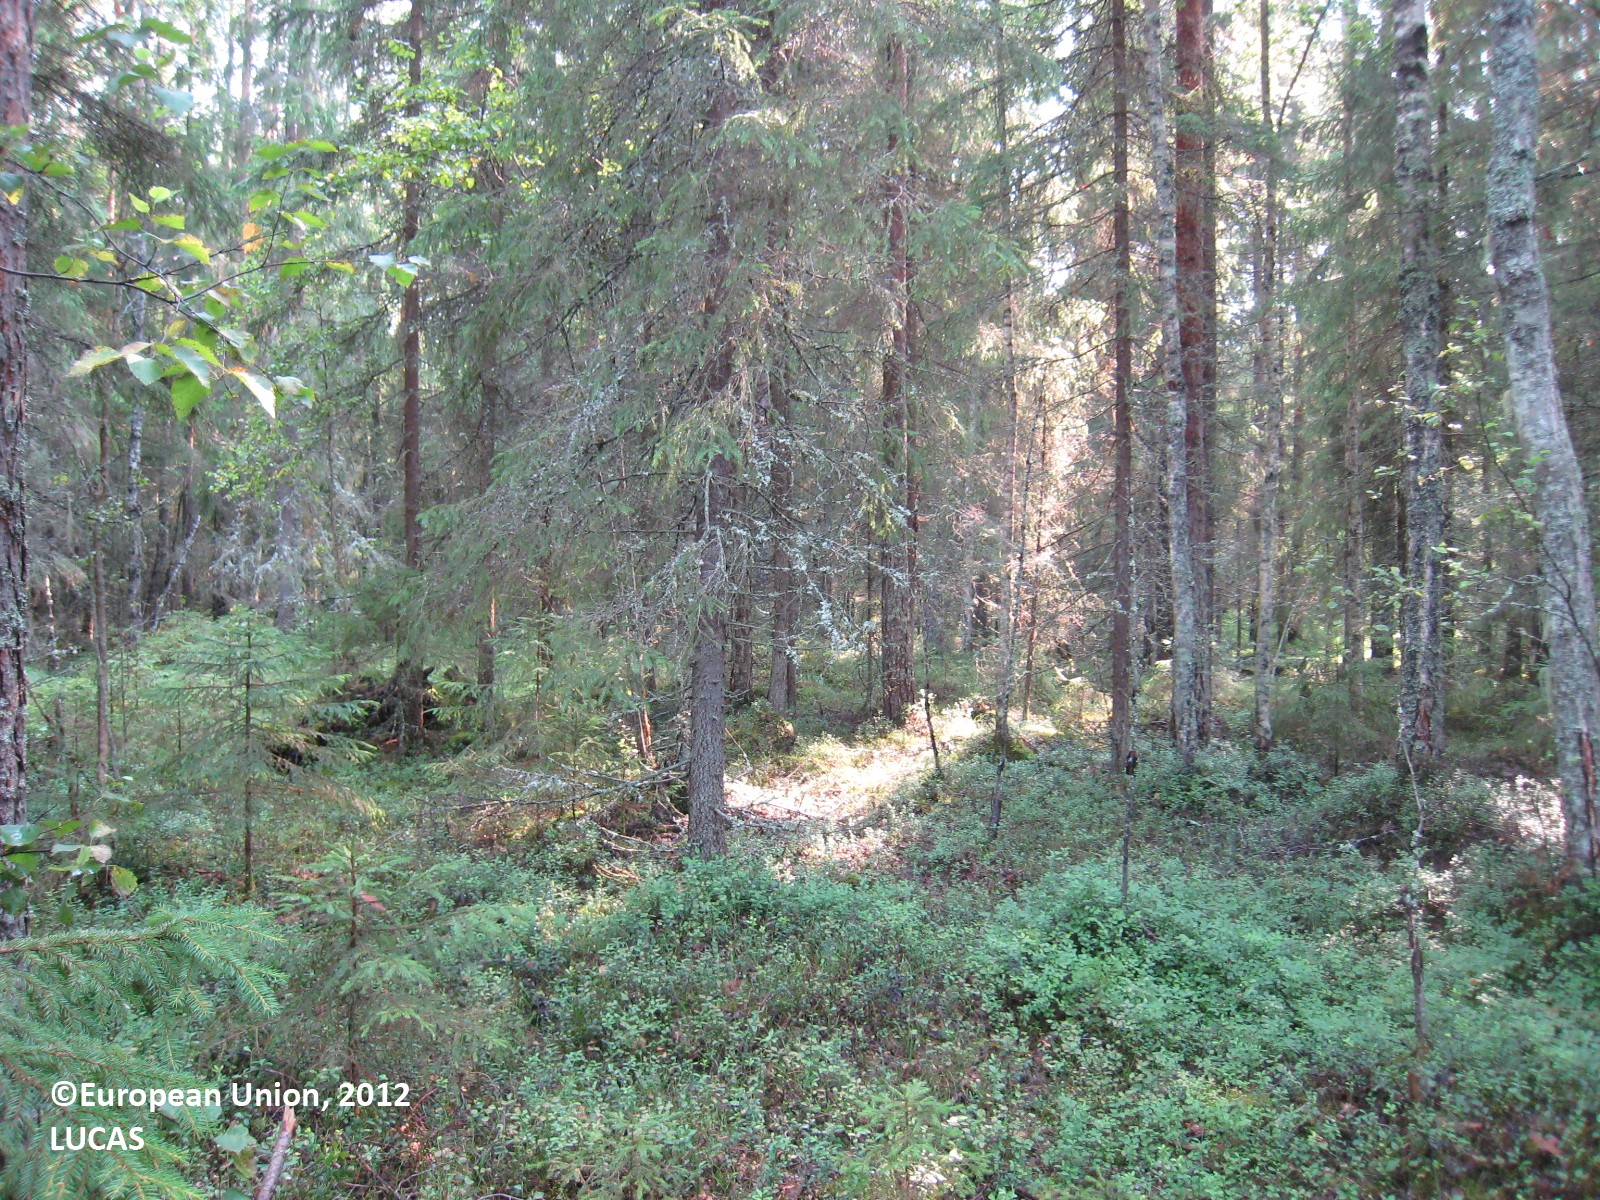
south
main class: Woodland
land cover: Other mixed woodland
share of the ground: > 75 %
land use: Forestry
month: July
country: FI
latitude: 62.4328
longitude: 27.3034
